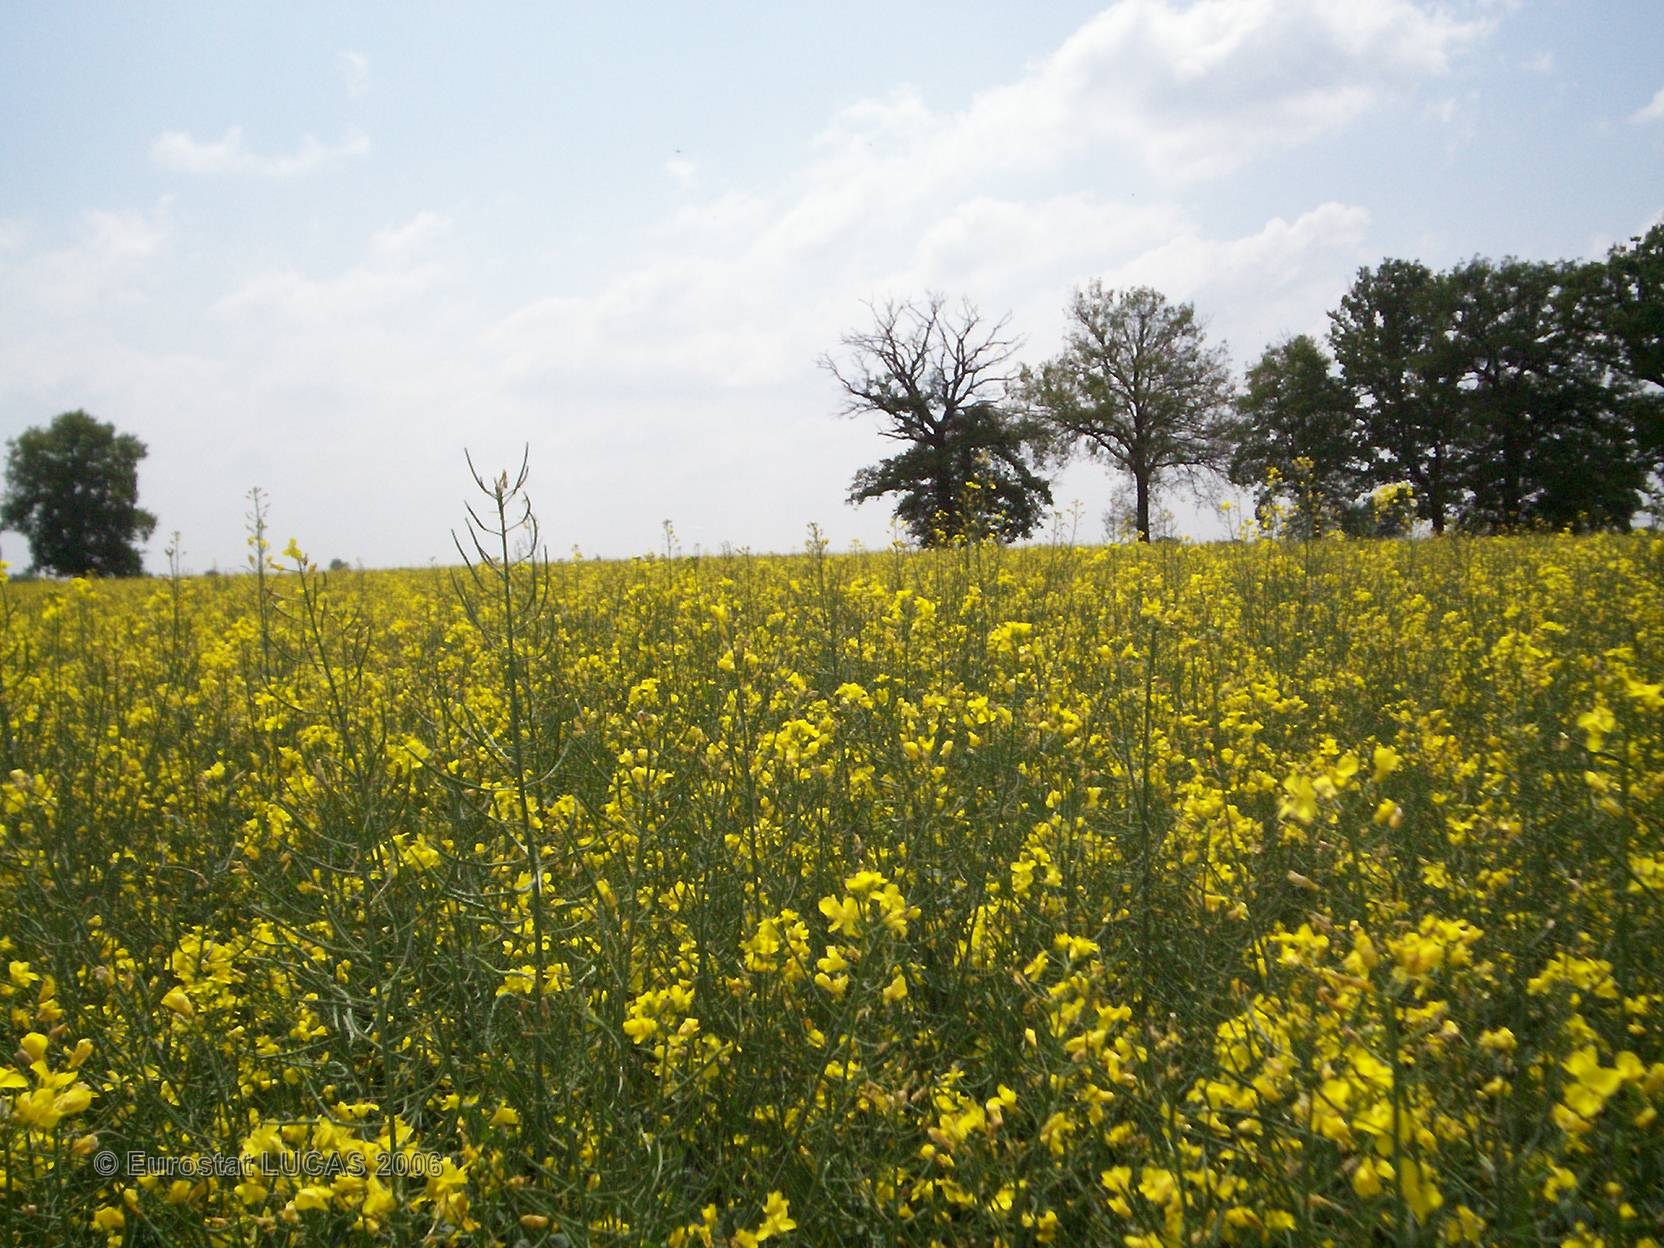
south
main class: Cropland
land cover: Rape and turnip rape
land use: Agriculture (excluding fallow land and kitchen gardens)
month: May
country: FR
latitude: 47.4976
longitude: 0.2192
